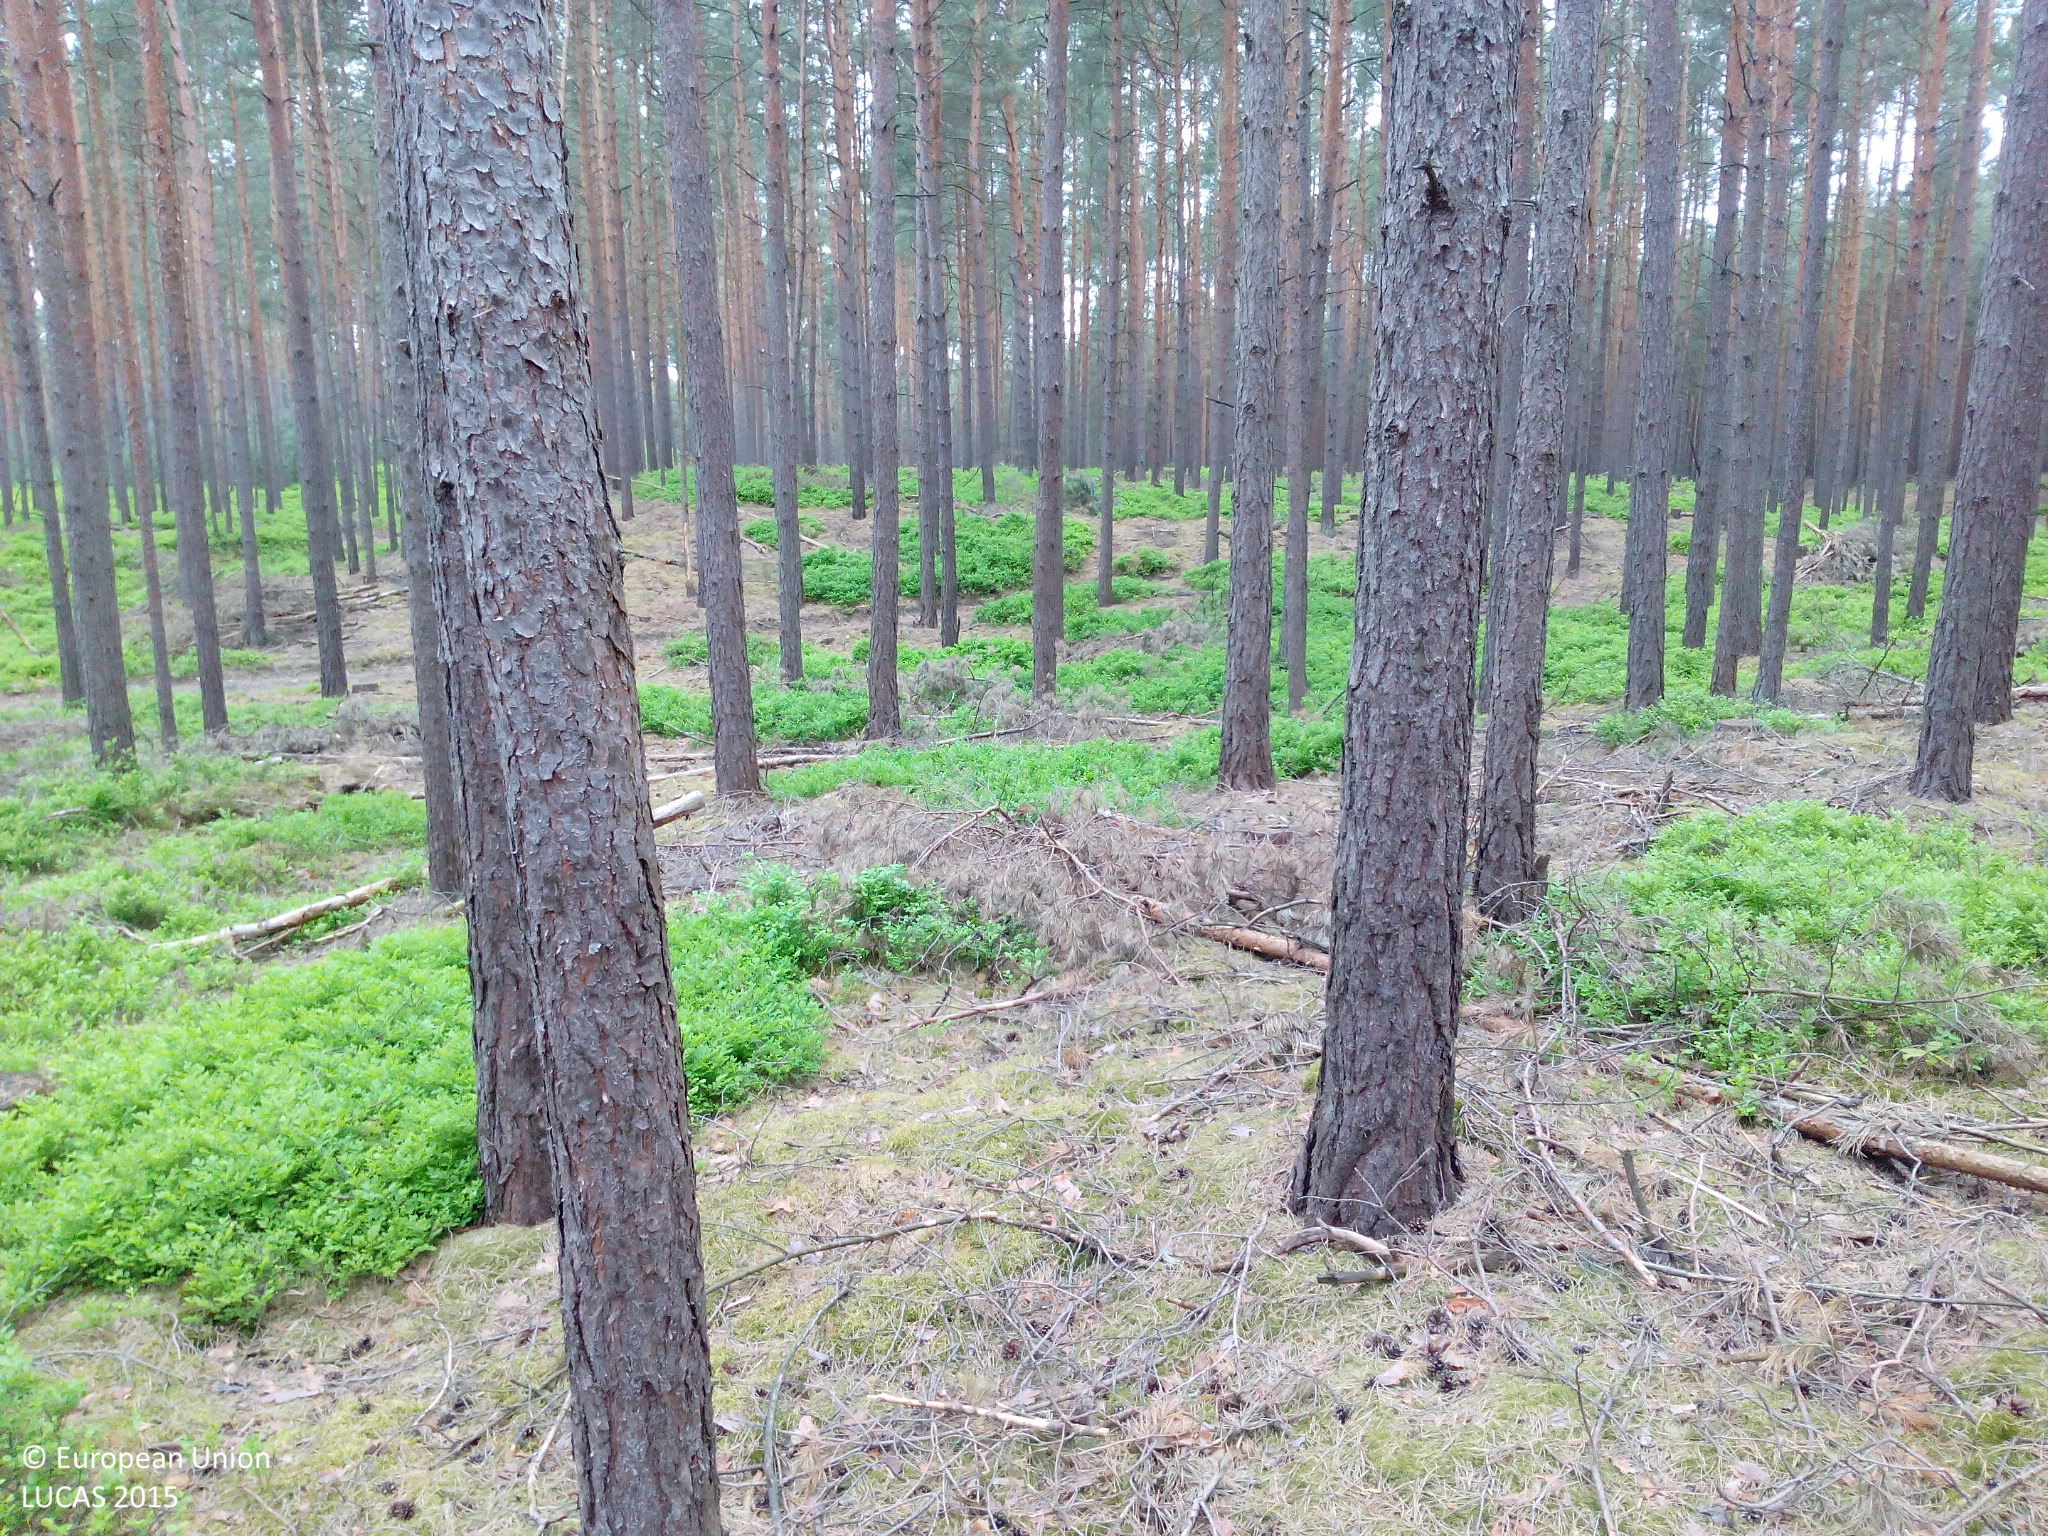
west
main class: Woodland
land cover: Pine dominated coniferous woodland
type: hemiboreal forest and nemoral coniferous forest and mixed broadleaved-coniferous forest
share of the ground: 25 - 50 %
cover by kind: coniferous forest trees 45 %, lichens and mosses 30 %, herbaceous plants 25 %
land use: Forestry
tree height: > 5 m
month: May
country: DE
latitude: 52.9073
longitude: 11.5012
